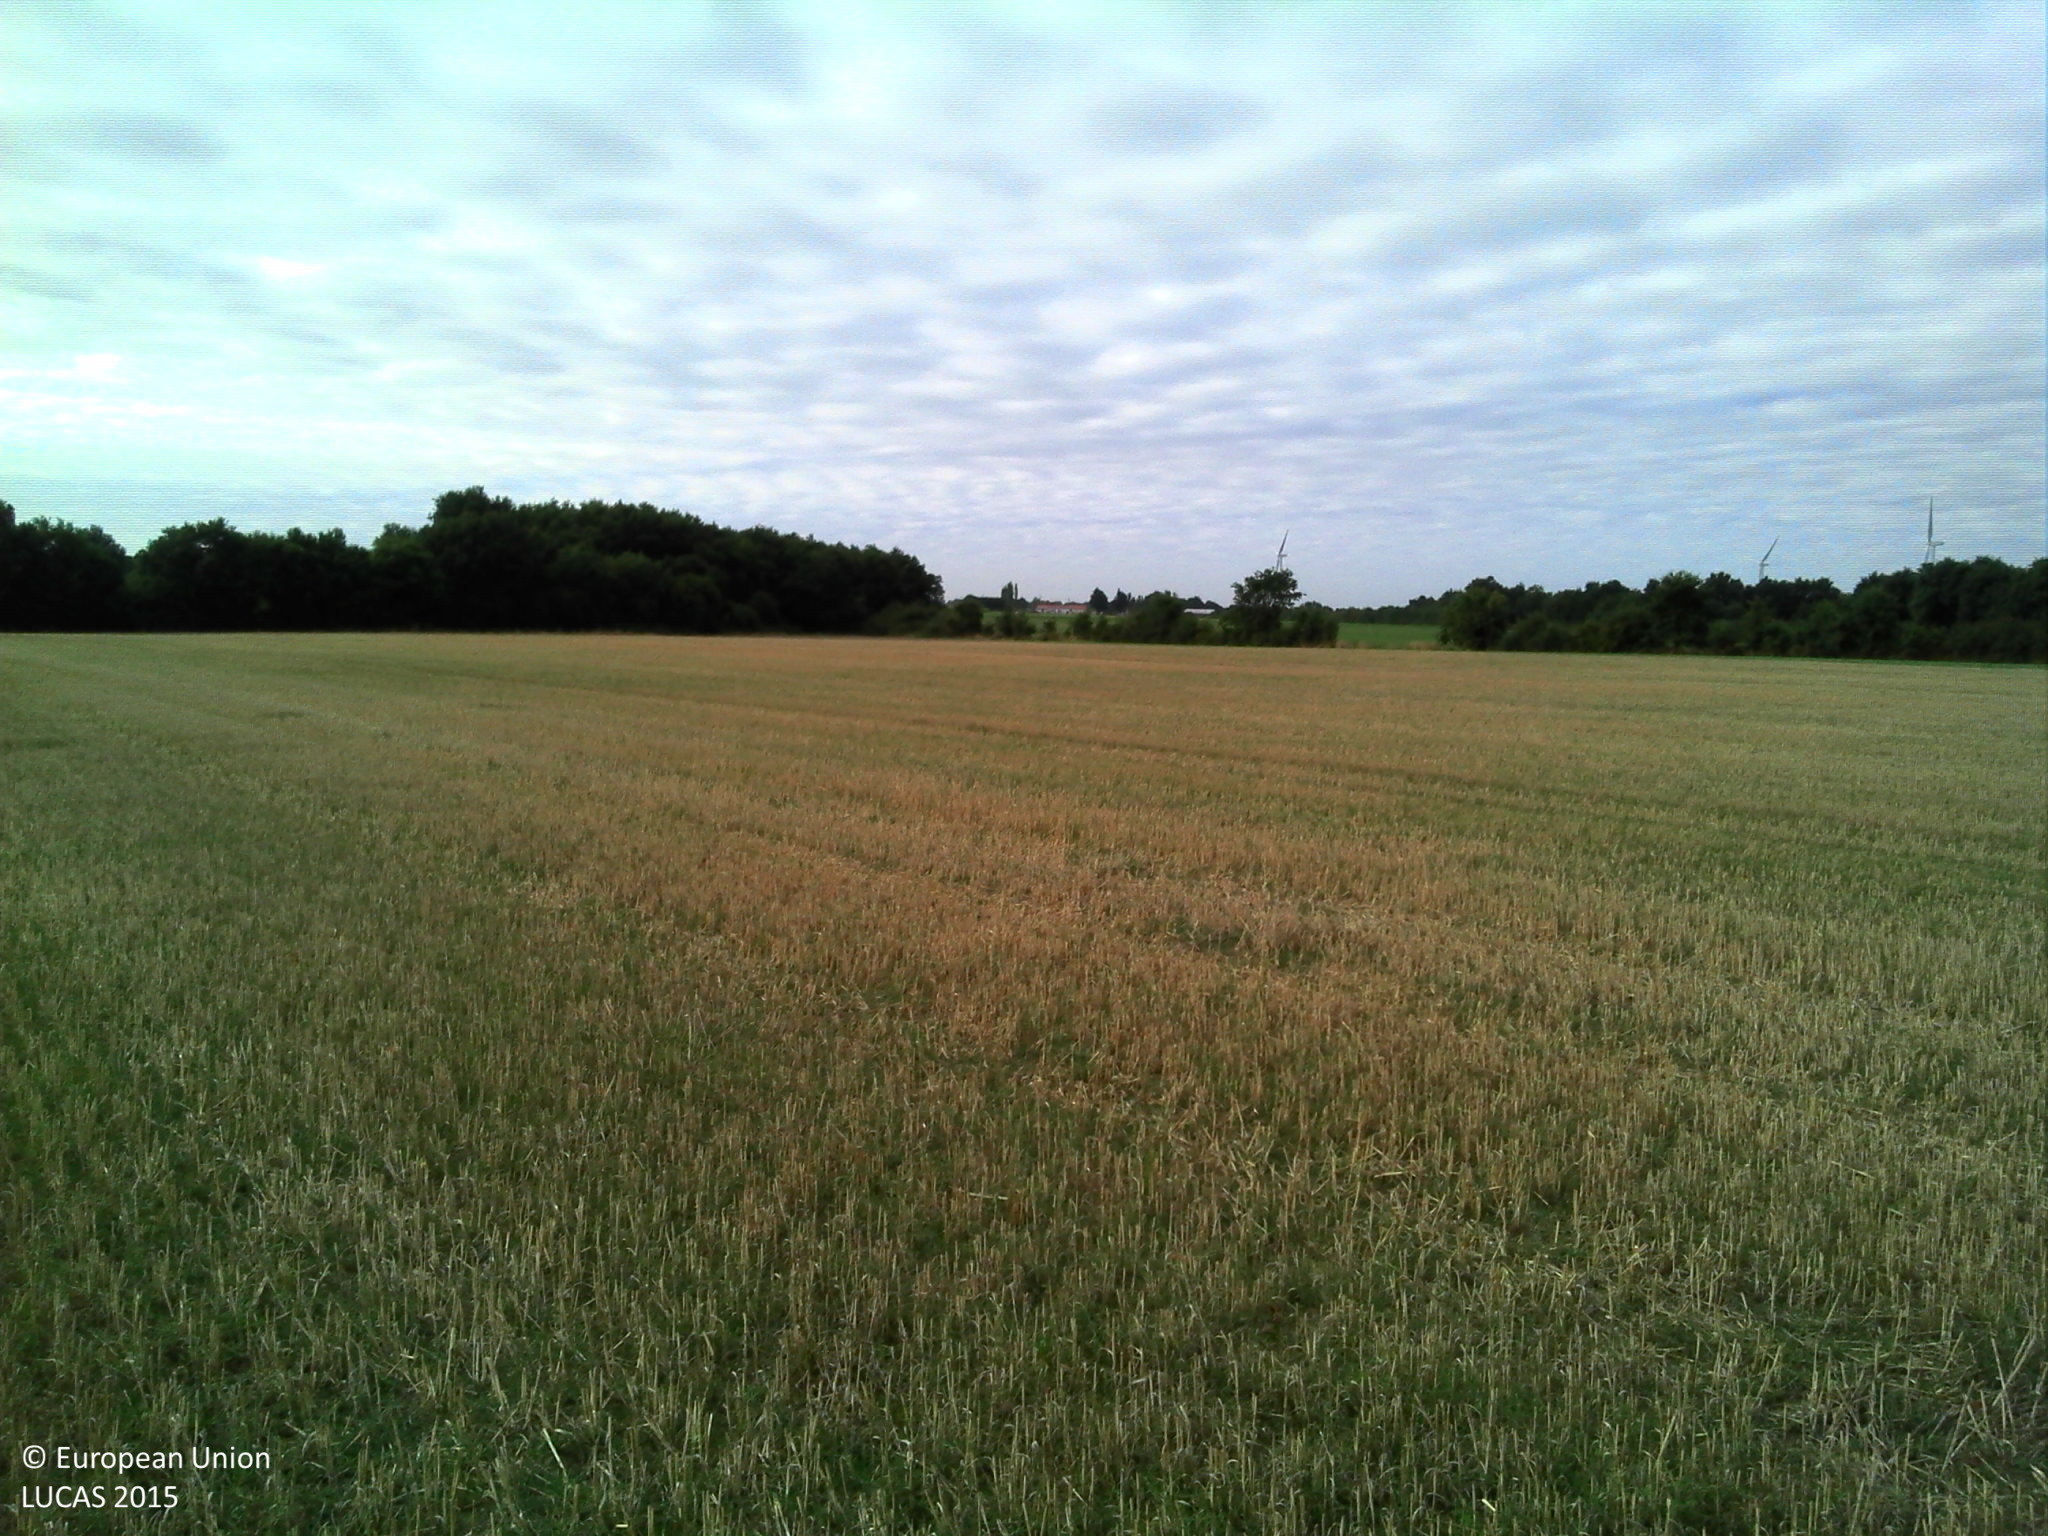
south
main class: Cropland
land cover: Common wheat
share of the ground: > 75 %
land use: Agriculture (excluding fallow land and kitchen gardens)
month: August
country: FR
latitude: 47.0225
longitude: -1.4733
